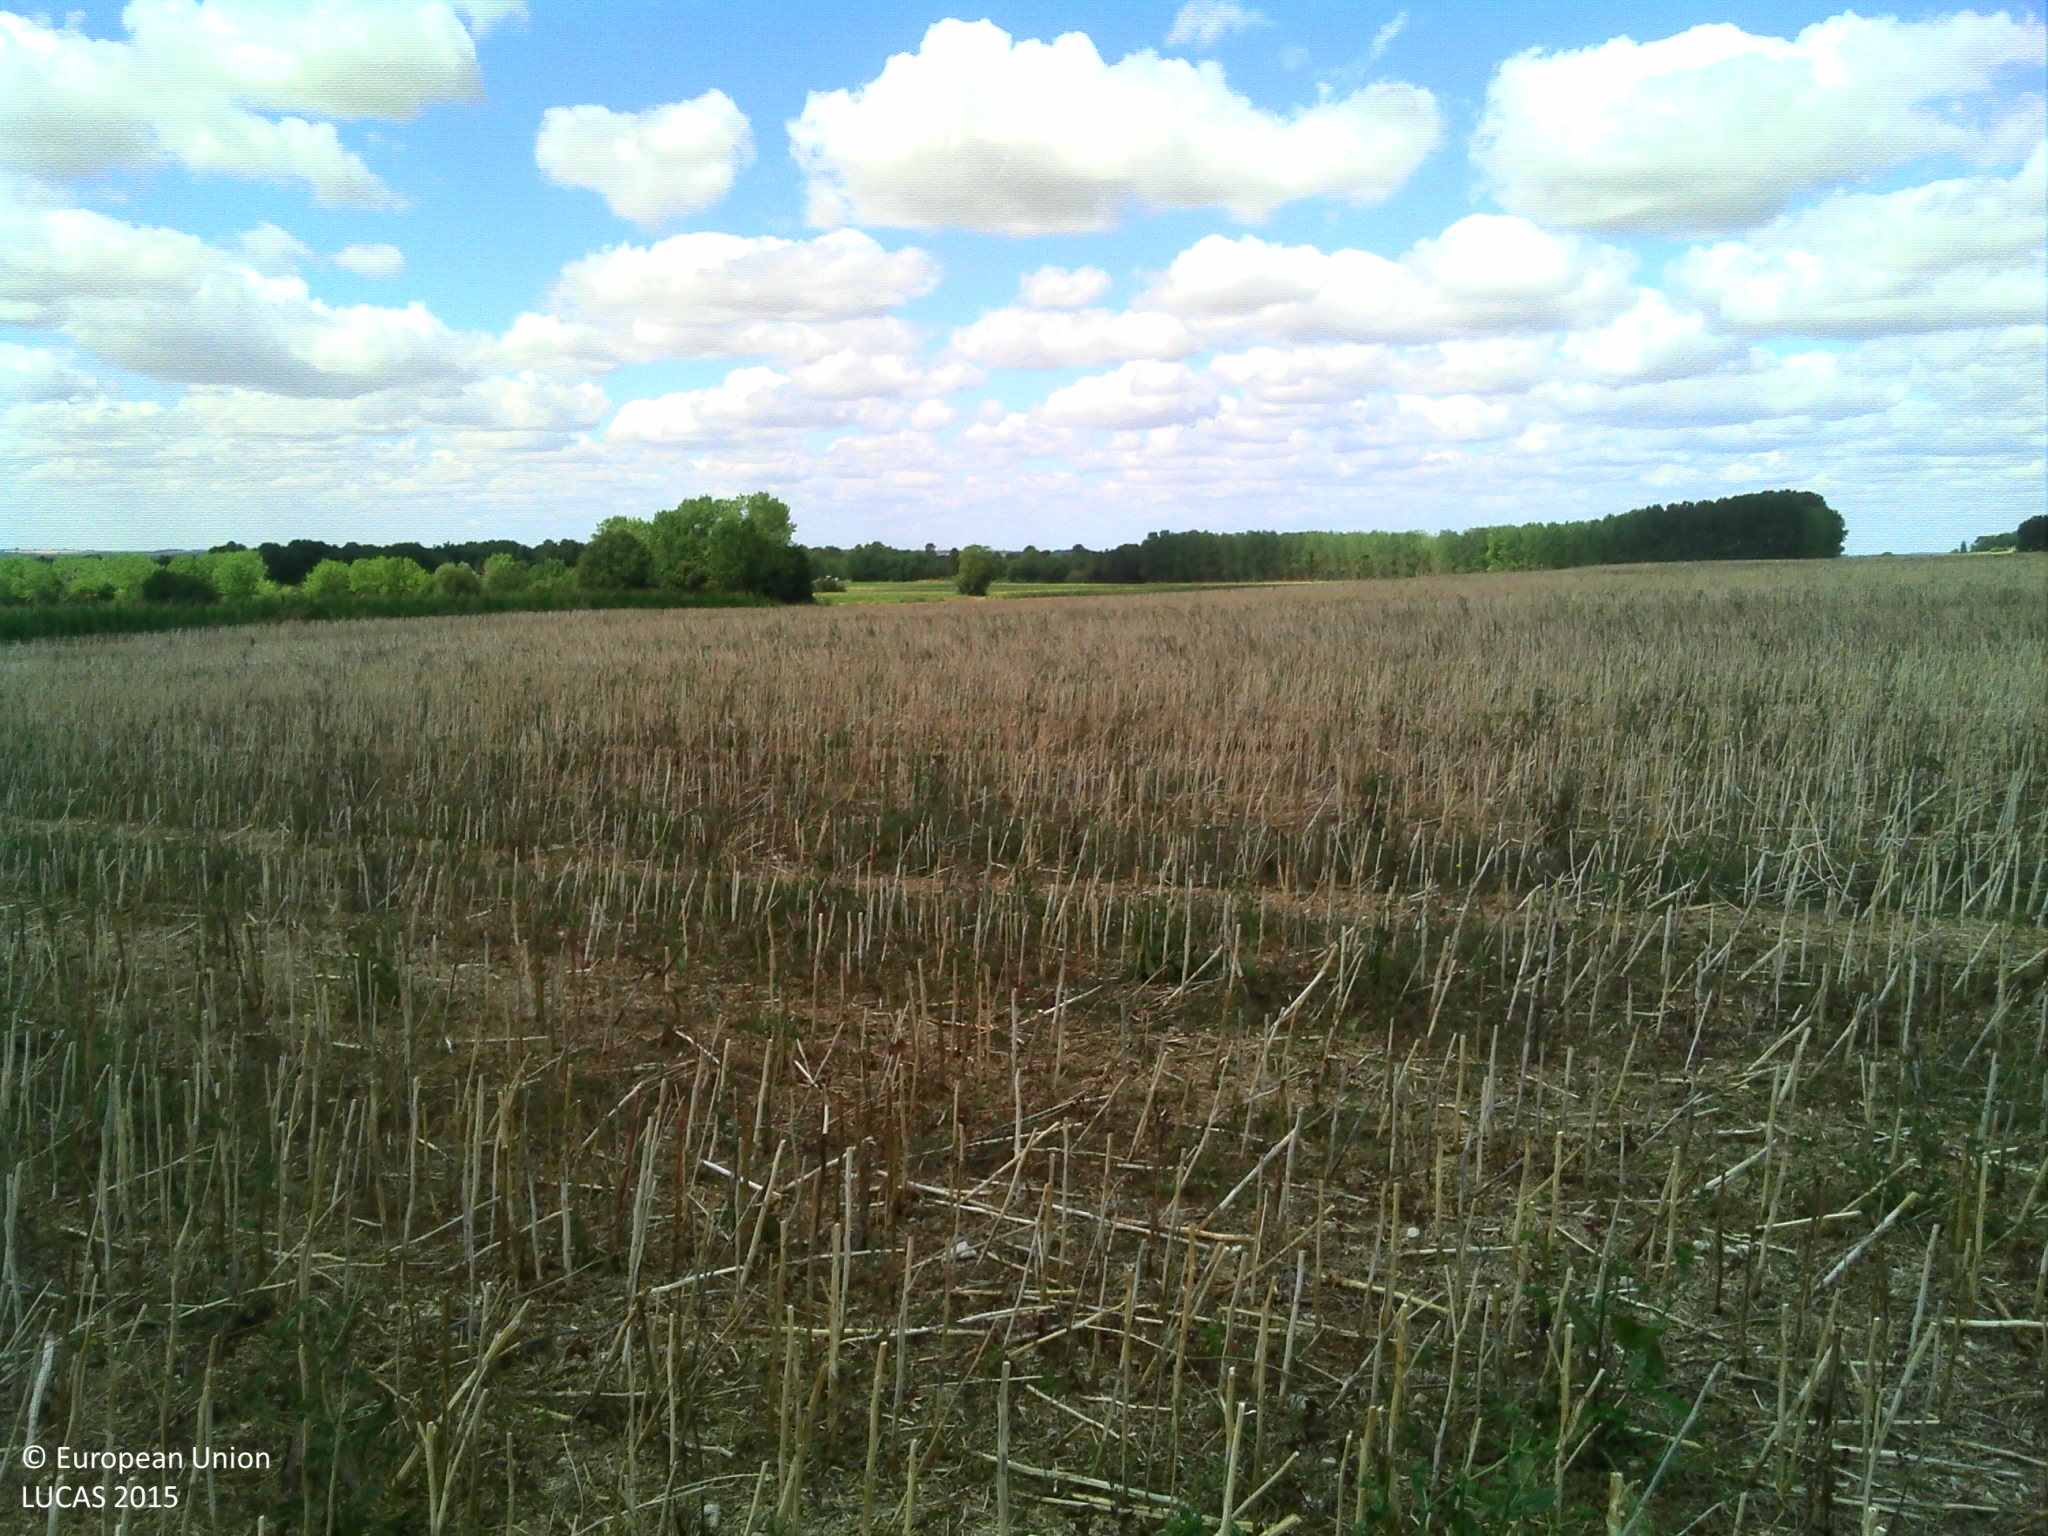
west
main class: Cropland
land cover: Rape and turnip rape
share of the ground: 10 - 25 %
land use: Agriculture (excluding fallow land and kitchen gardens)
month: July
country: FR
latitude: 47.0055
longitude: 0.3914
